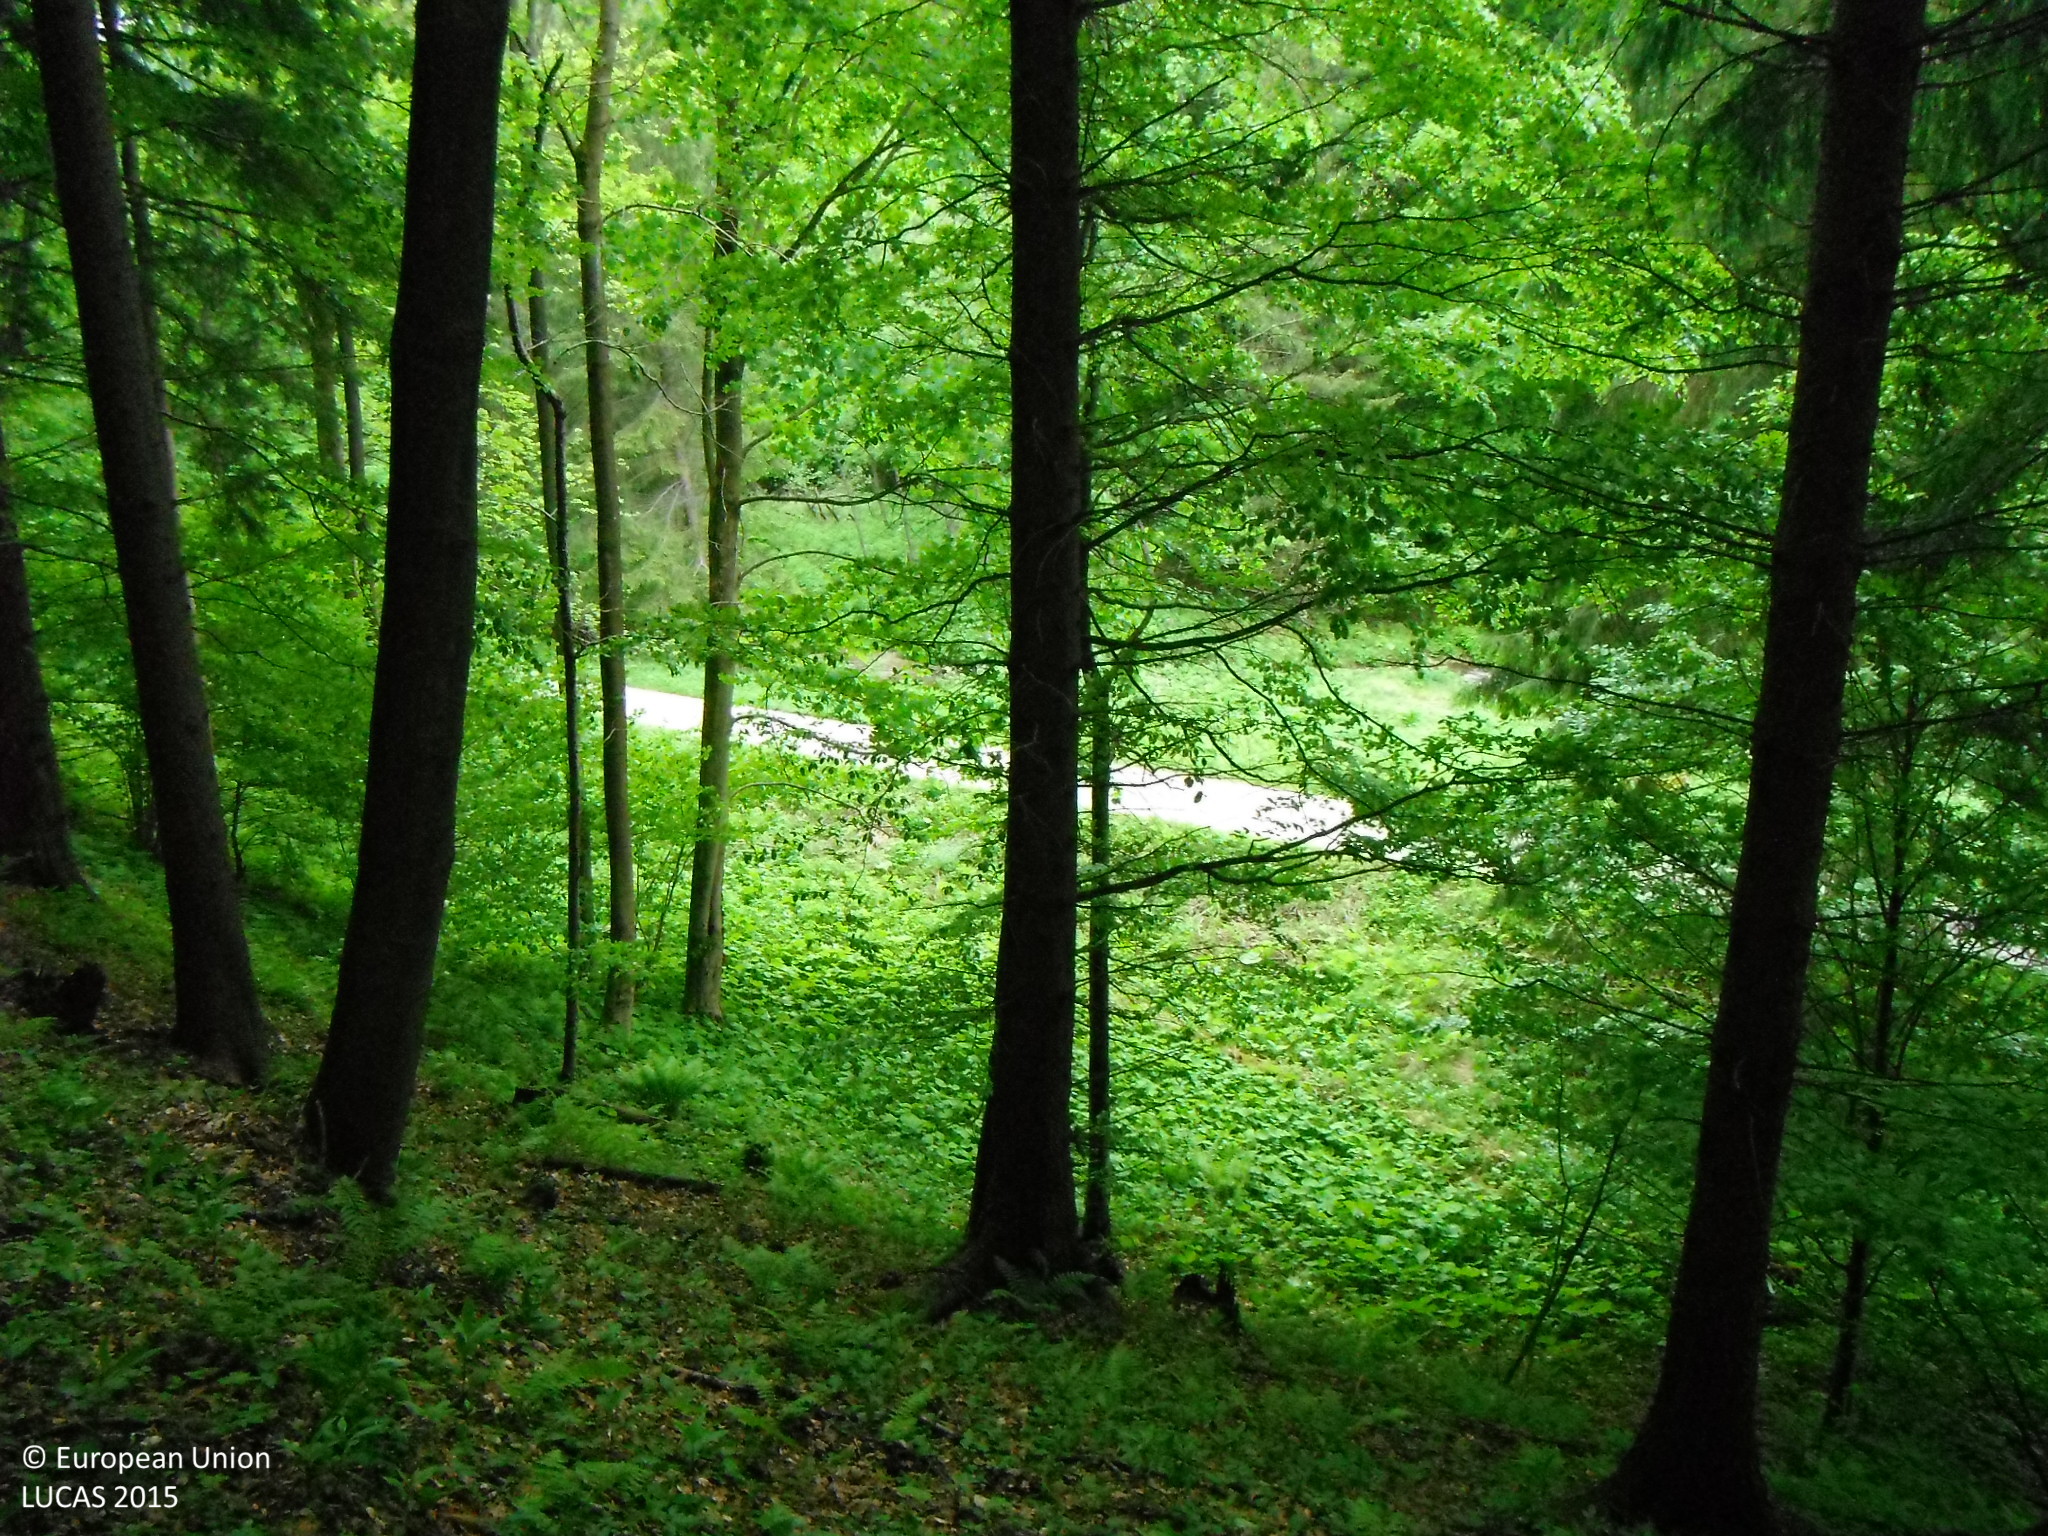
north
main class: Grassland
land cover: Spontaneously vegetated surfaces
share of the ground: > 75 %
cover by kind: herbaceous plants 95 %, shrubs 5 %
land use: Forestry
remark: Clear cut
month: May
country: SK
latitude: 49.0325
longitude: 18.7599
